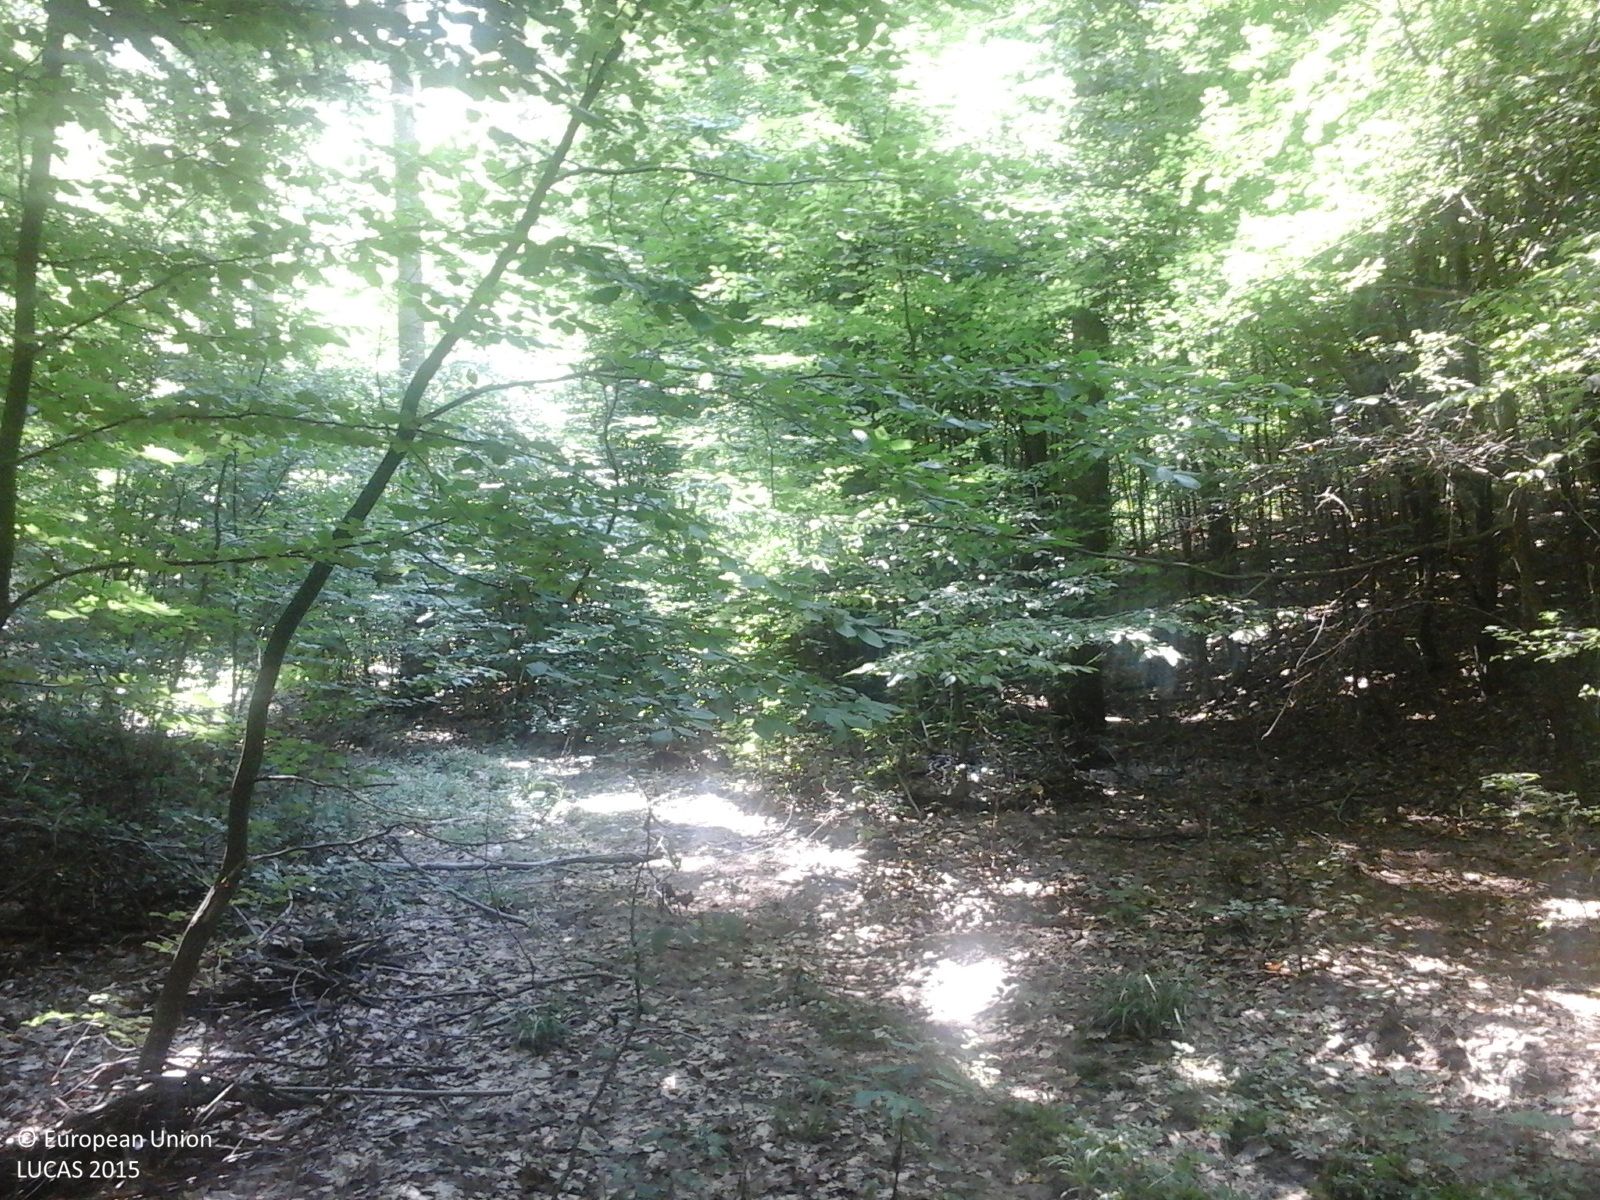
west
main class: Woodland
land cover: Broadleaved woodland
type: mesophytic deciduous forest
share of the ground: > 75 %
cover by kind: broadleaved forest trees 100 %
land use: Forestry
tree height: > 5 m
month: July
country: RO
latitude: 44.7728
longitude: 24.7488
